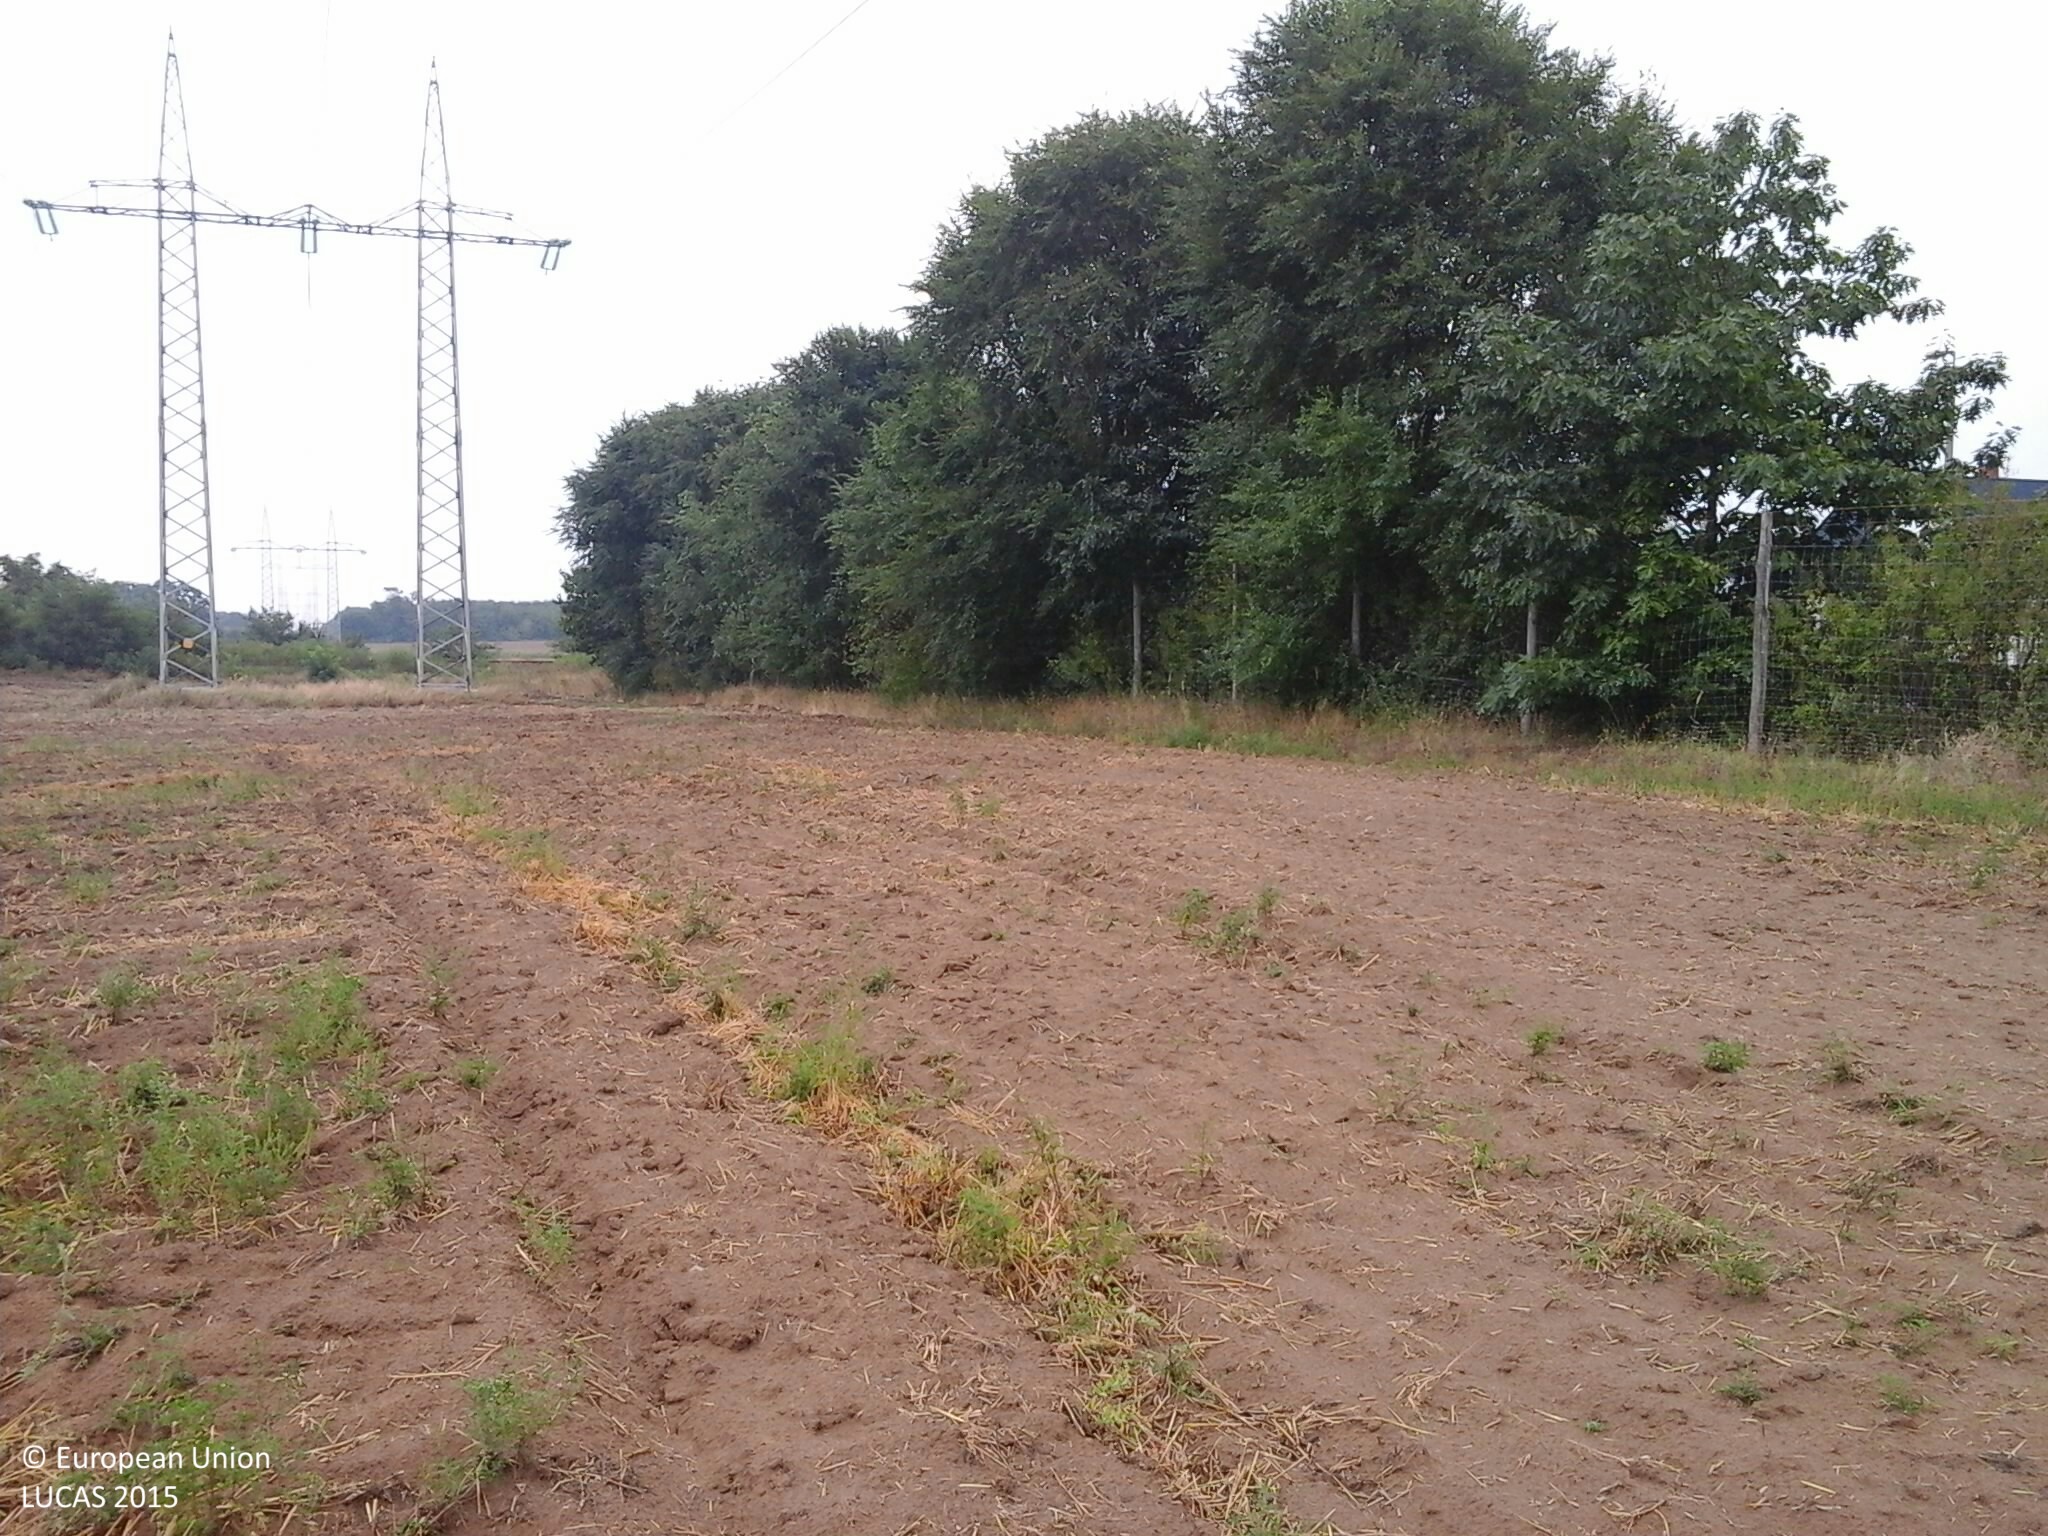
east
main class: Cropland
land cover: Common wheat
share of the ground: 10 - 25 %
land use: Agriculture (excluding fallow land and kitchen gardens)
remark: Harvested field
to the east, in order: Common wheat; Electric lines; Common wheat; Fences; Shrubland with sparse tree cover; Fences; Grassland with sparse tree/shrub cover; Railways; Ditches and canals; Grassland with sparse tree/shrub cover; Tracks; Grass margins; Lucerne
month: August
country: HU
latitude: 47.7234
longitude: 20.2818
